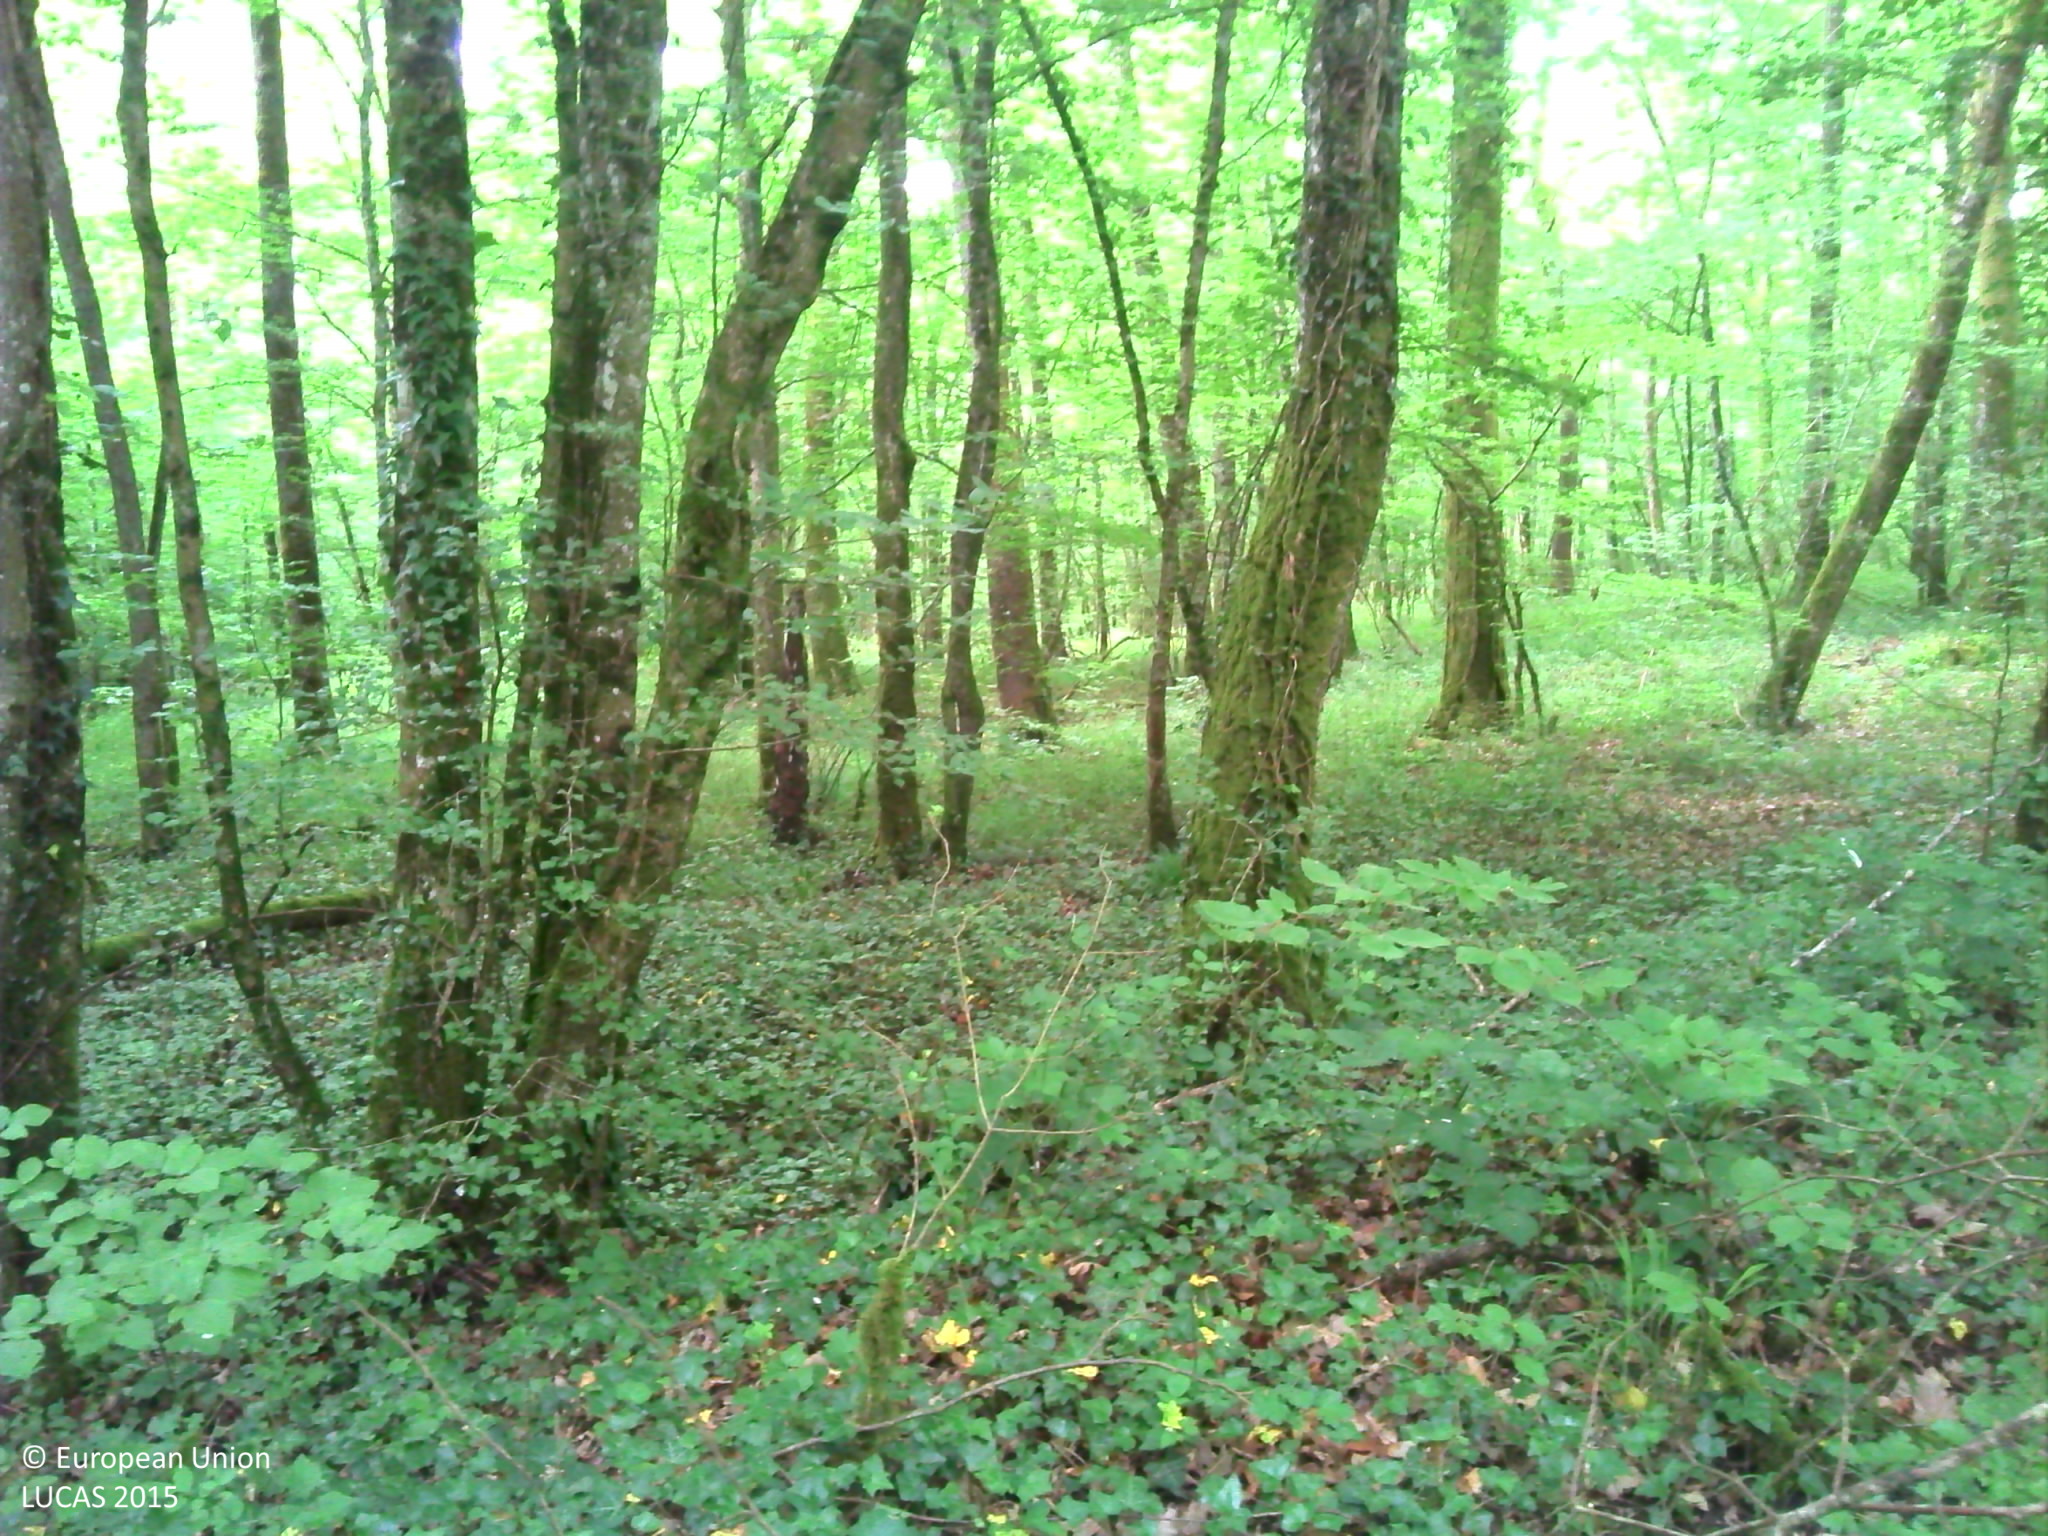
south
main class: Woodland
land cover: Broadleaved woodland
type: beech forest
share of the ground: > 75 %
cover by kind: broadleaved forest trees 90 %, herbaceous plants 10 %
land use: Forestry
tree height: > 5 m
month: June
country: FR
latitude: 47.7653
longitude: 6.3053
